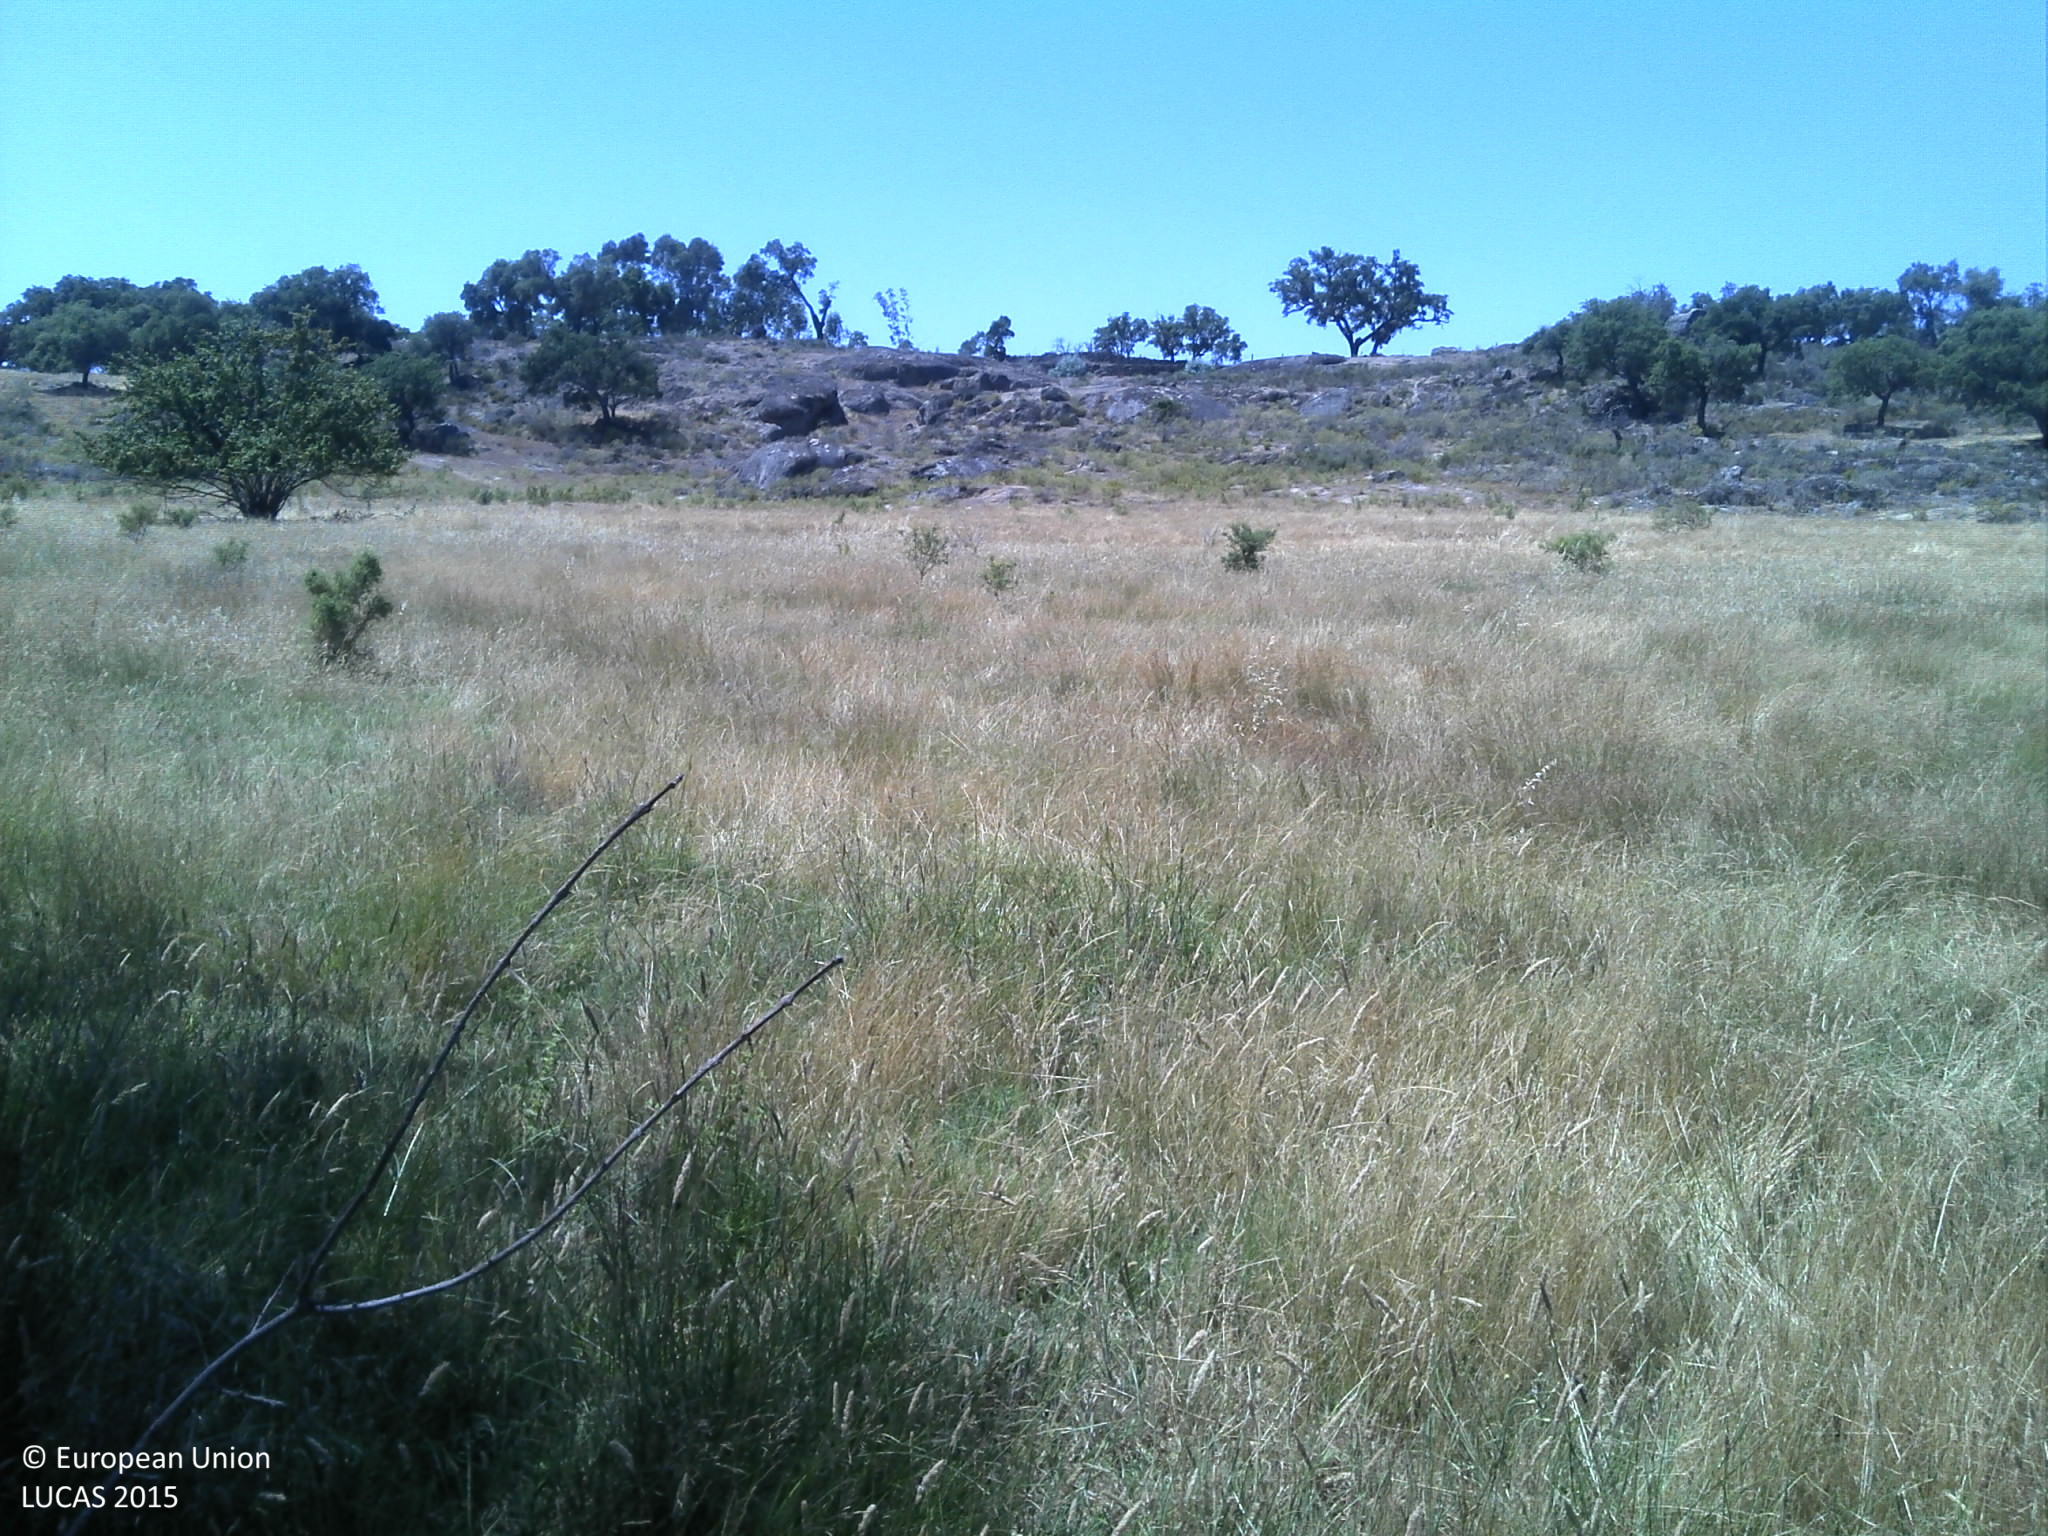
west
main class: Grassland
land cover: Grassland without tree/shrub cover
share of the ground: 50 - 75 %
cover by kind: herbaceous plants 60 %, unconsolidated bare surface 30 %, shrubs 5 %
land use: Agriculture (excluding fallow land and kitchen gardens)
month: June
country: PT
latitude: 39.8816
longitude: -7.3917
